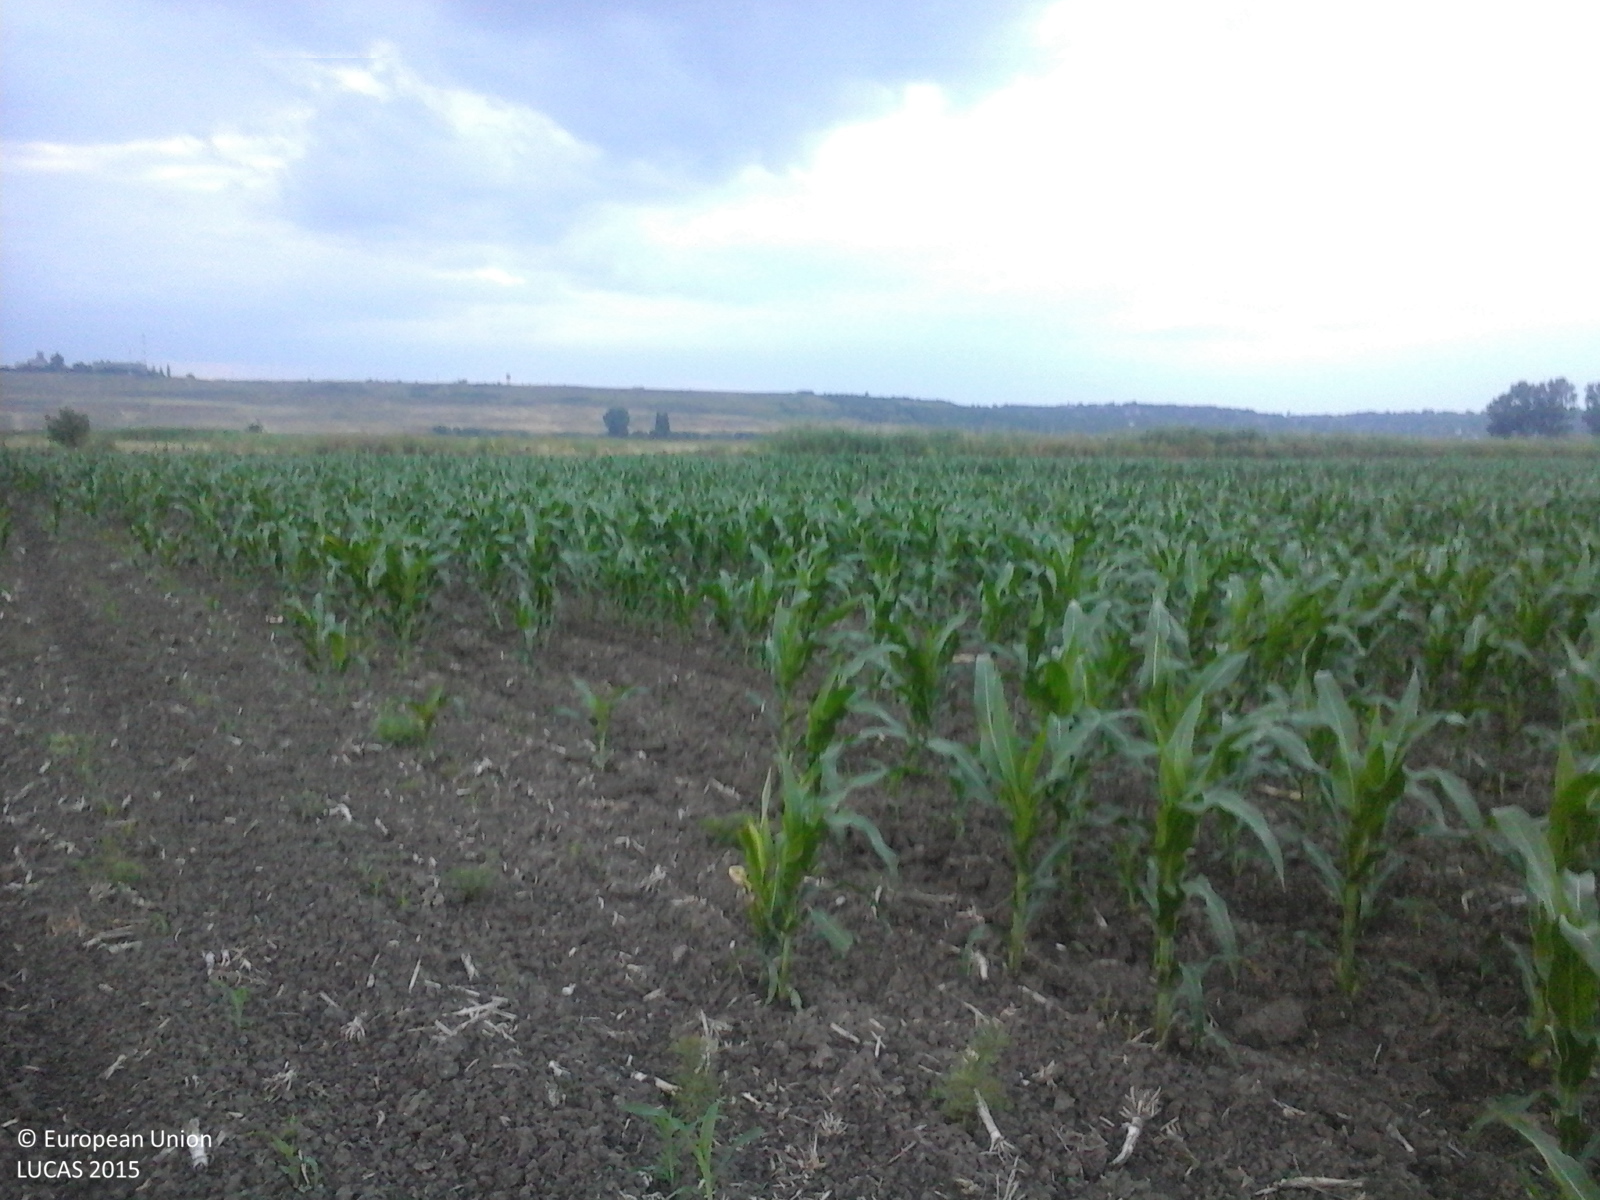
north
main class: Cropland
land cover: Maize
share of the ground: 25 - 50 %
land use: Agriculture (excluding fallow land and kitchen gardens)
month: June
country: RO
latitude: 44.0365
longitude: 26.1111
